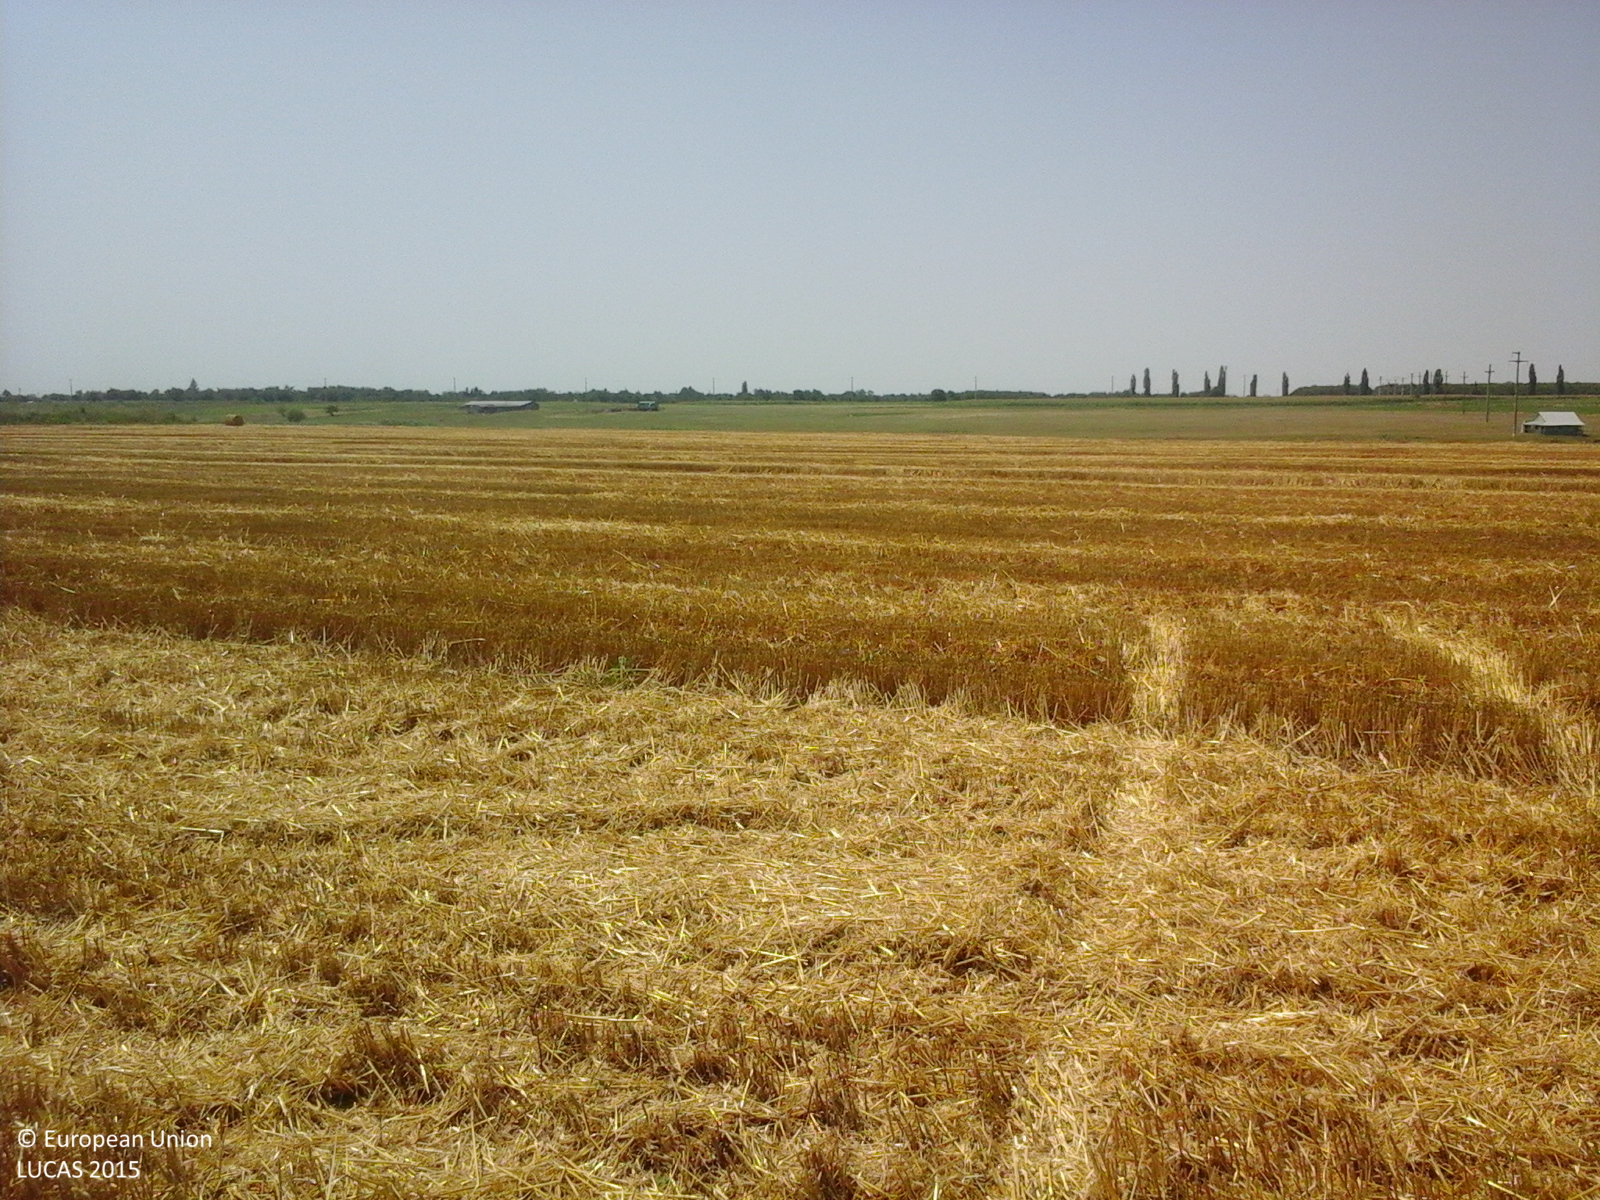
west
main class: Cropland
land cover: Common wheat
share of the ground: > 75 %
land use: Agriculture (excluding fallow land and kitchen gardens)
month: July
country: RO
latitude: 44.7019
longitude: 27.1088
